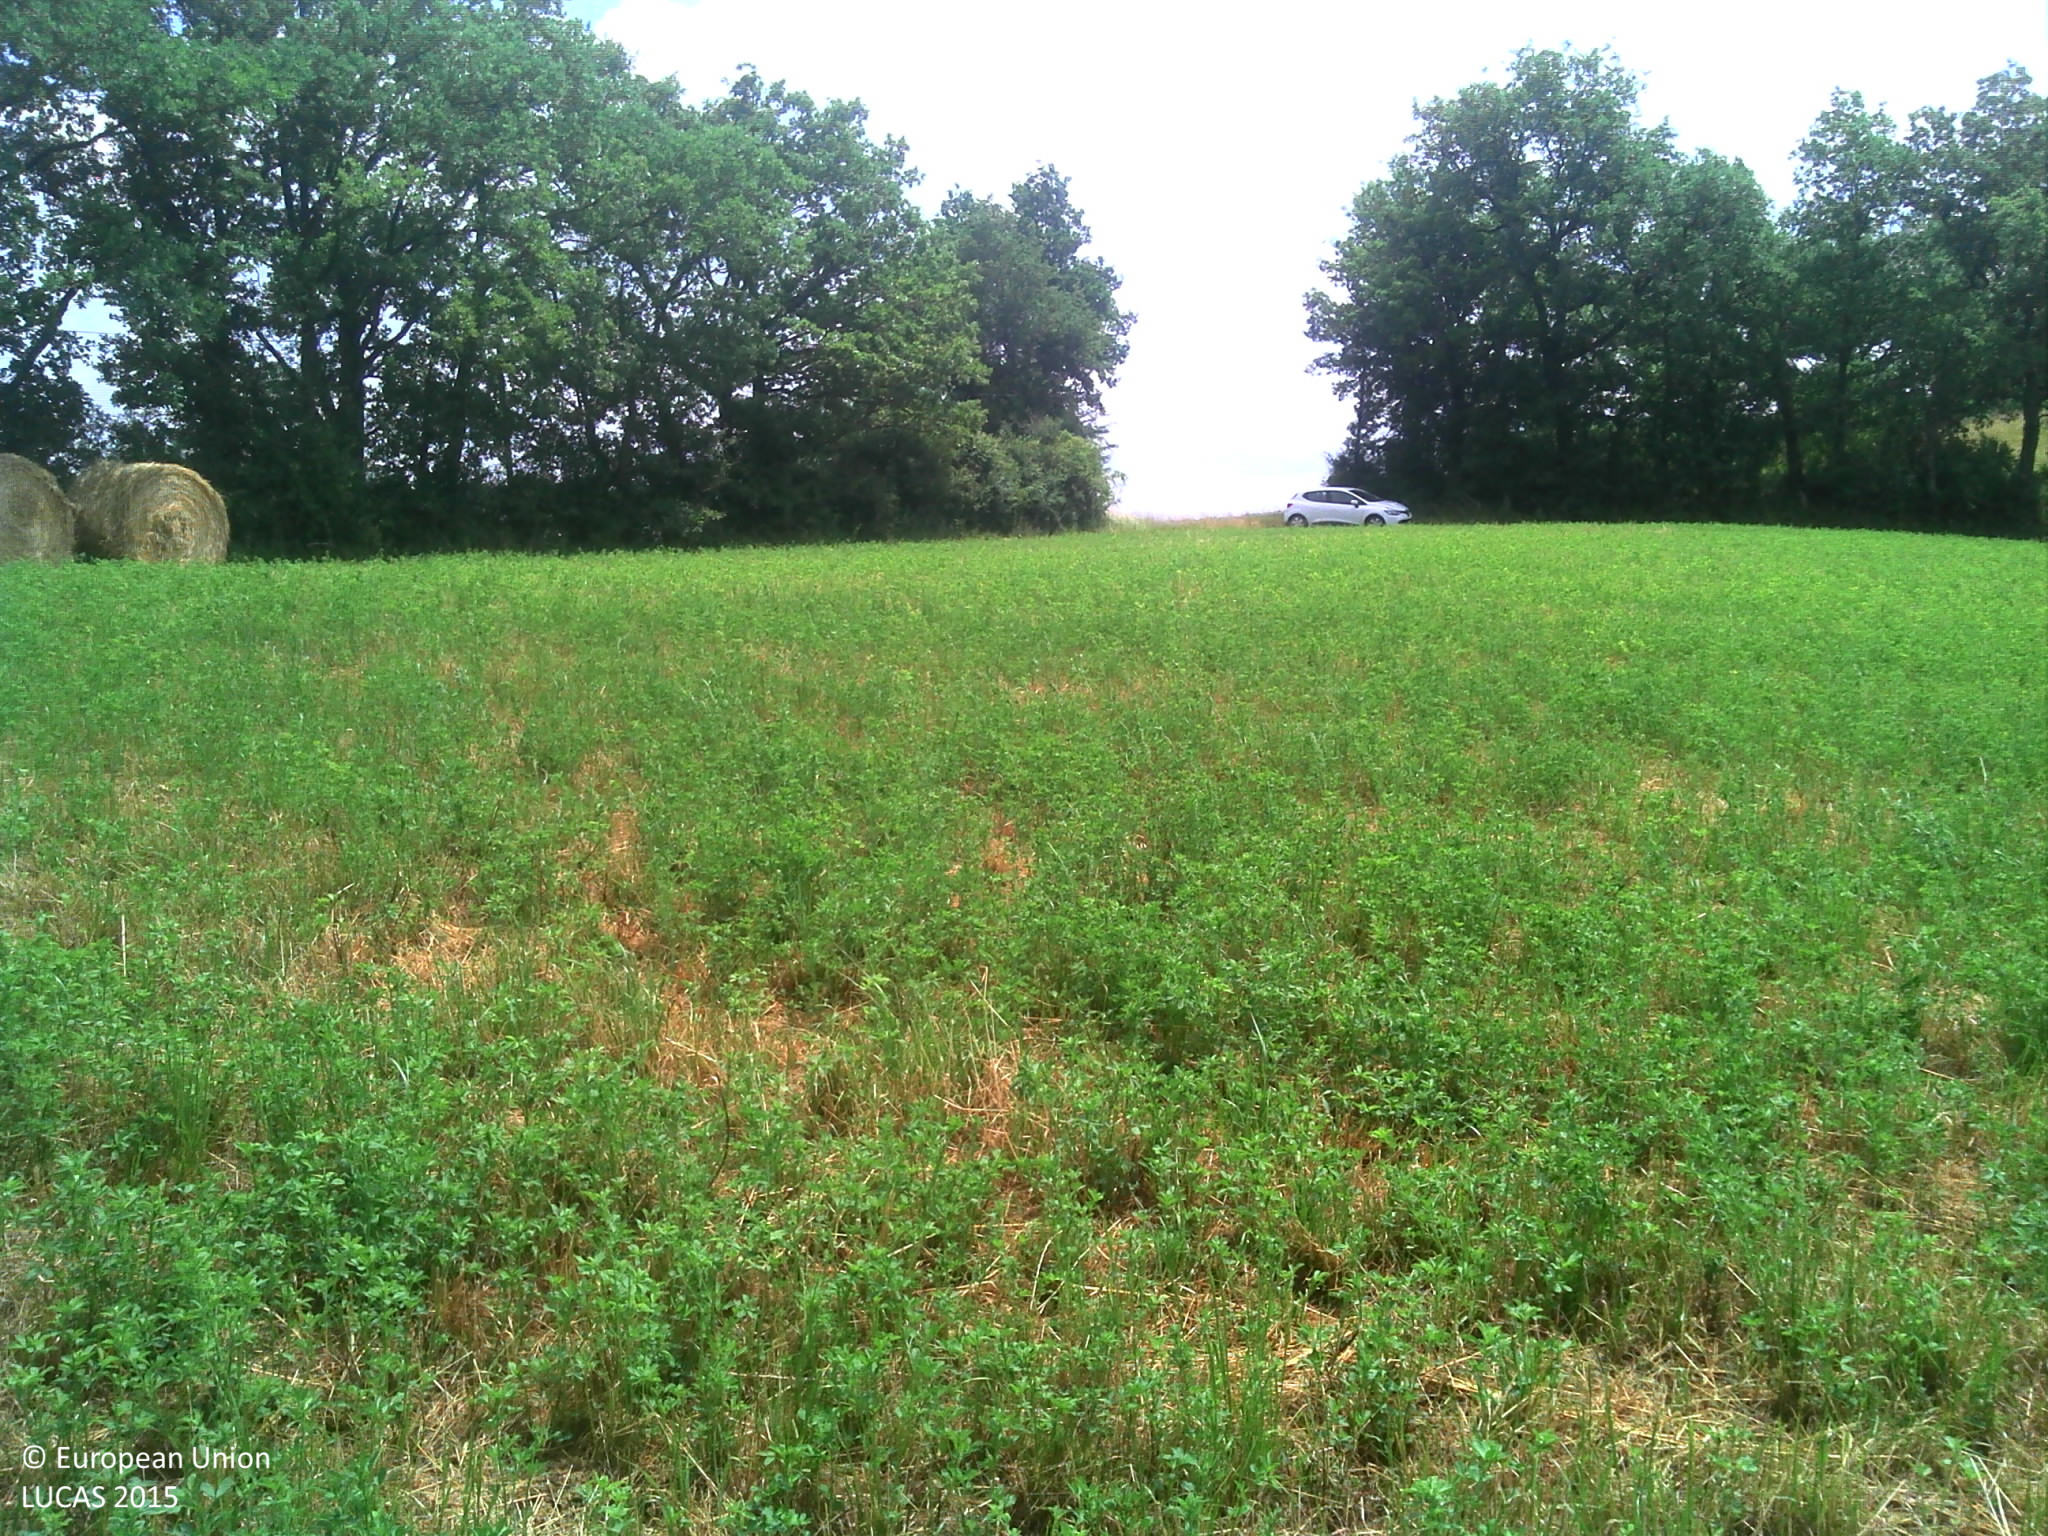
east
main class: Cropland
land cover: Lucerne
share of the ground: > 75 %
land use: Agriculture (excluding fallow land and kitchen gardens)
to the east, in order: Lucerne; Lines of trees; Electric lines; Grass margins; Paved roads, cycling and walking lanes; Grass margins; Temporary grasslands; Abandoned hedges; Rape and turnip rape
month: June
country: FR
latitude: 43.7605
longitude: 2.1172
